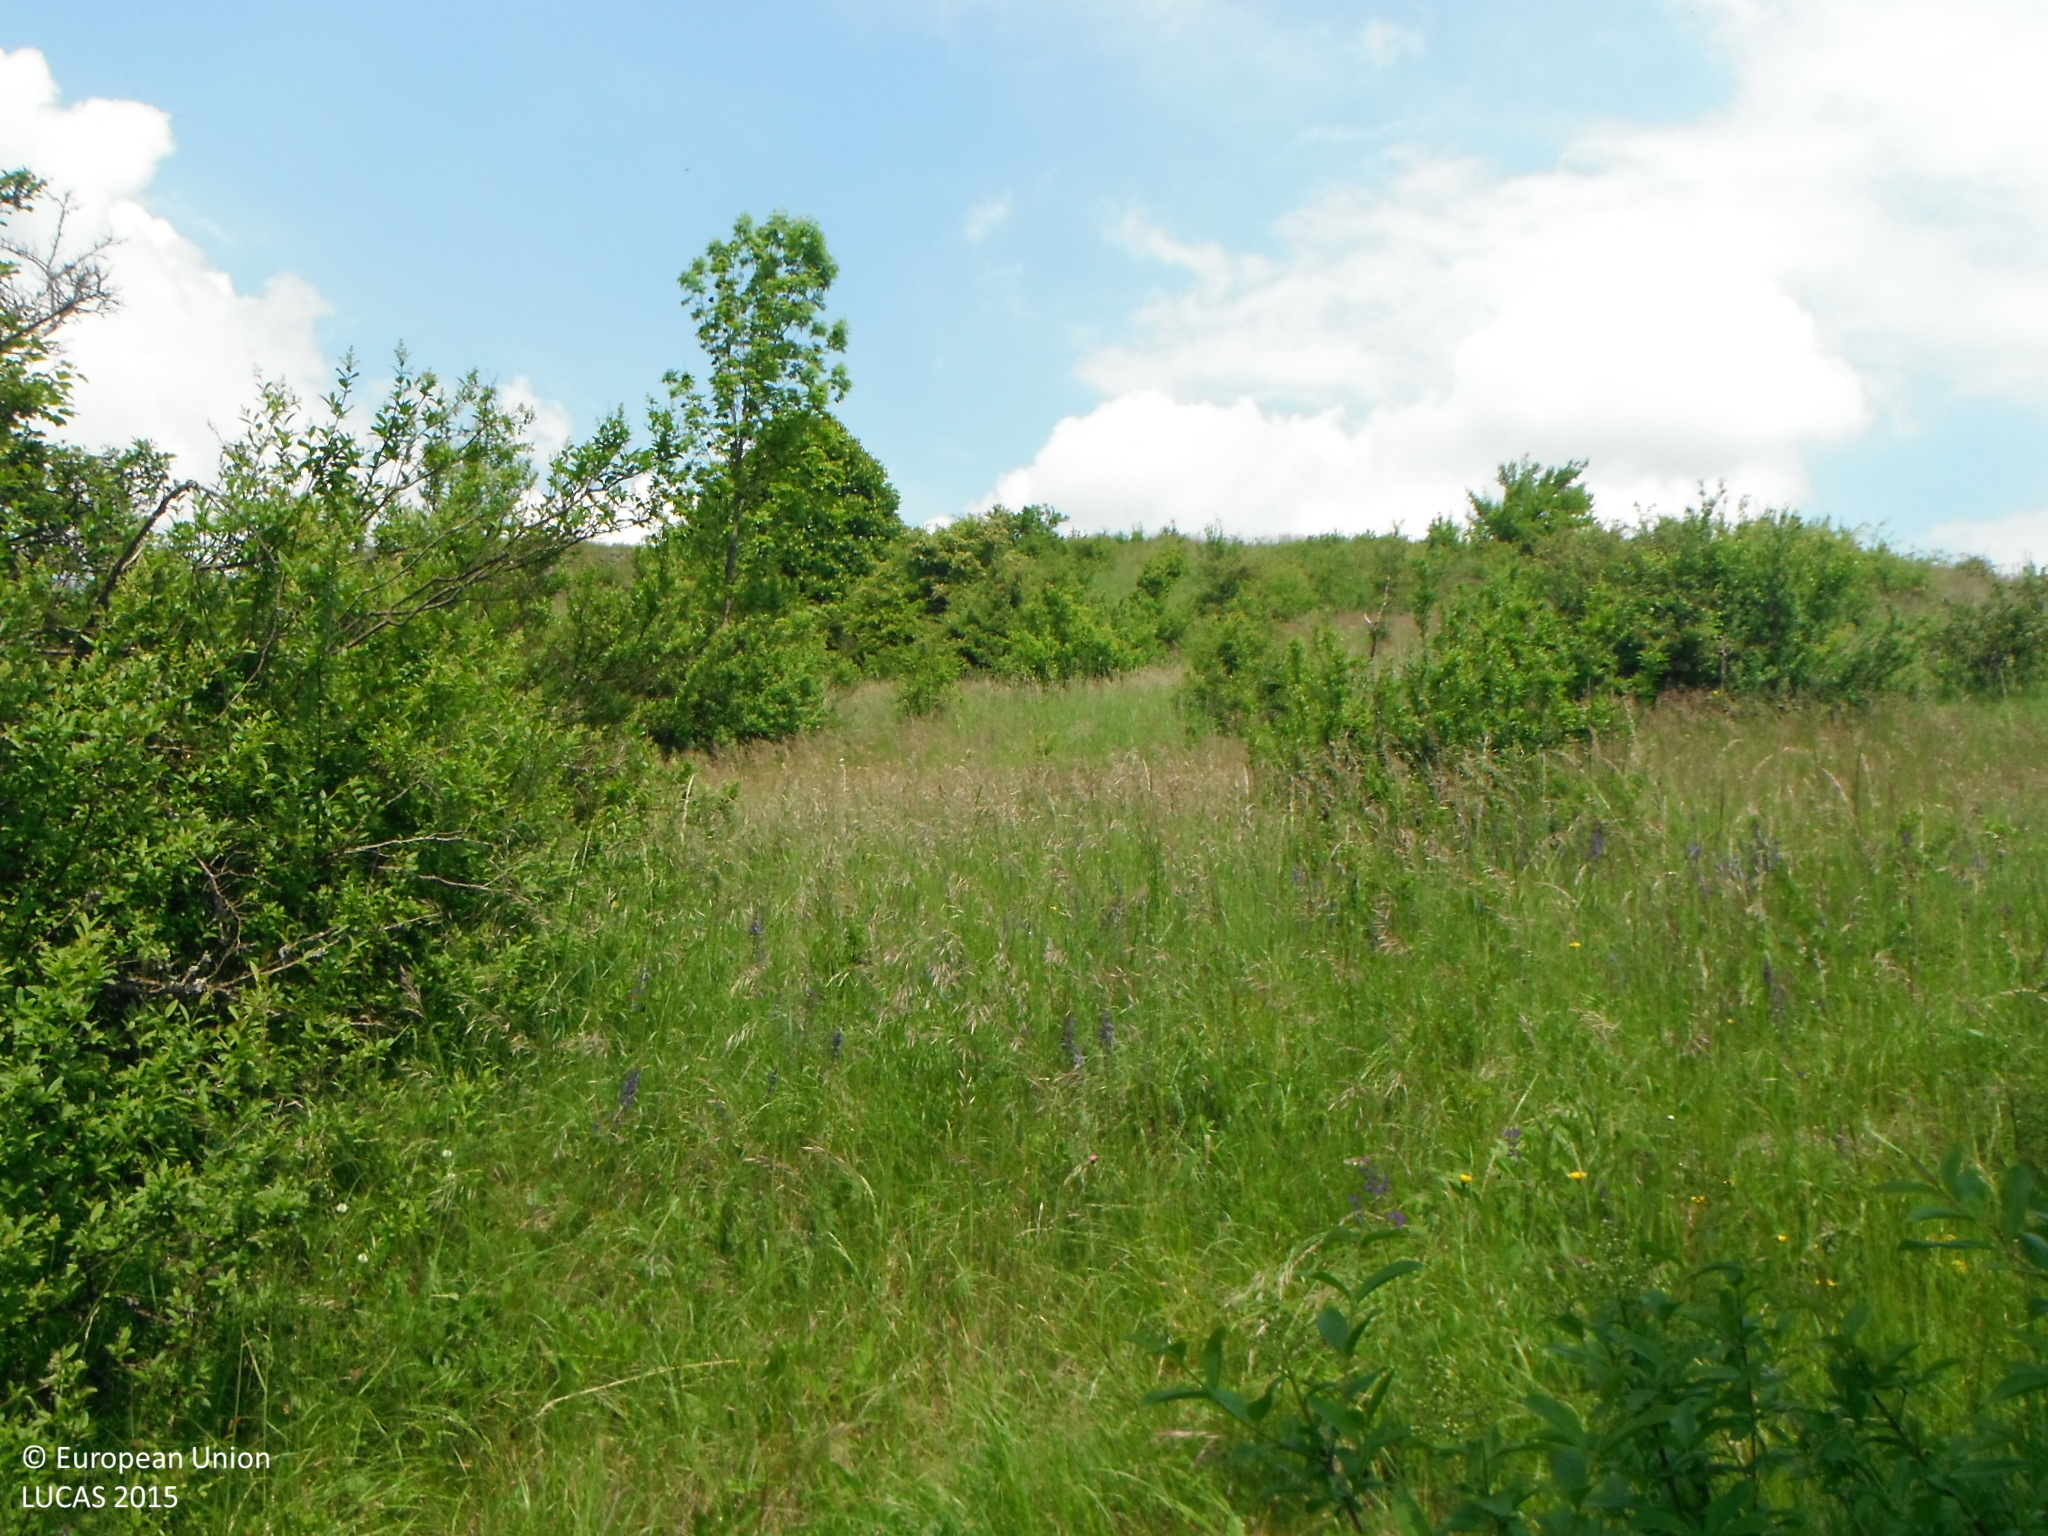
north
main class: Shrubland
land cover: Shrubland with sparse tree cover
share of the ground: > 75 %
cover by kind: shrubs 85 %, herbaceous plants 10 %, broadleaved forest trees 5 %
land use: Semi-natural and natural areas not in use
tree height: > 5 m
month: June
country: SK
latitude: 48.8275
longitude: 19.4927
